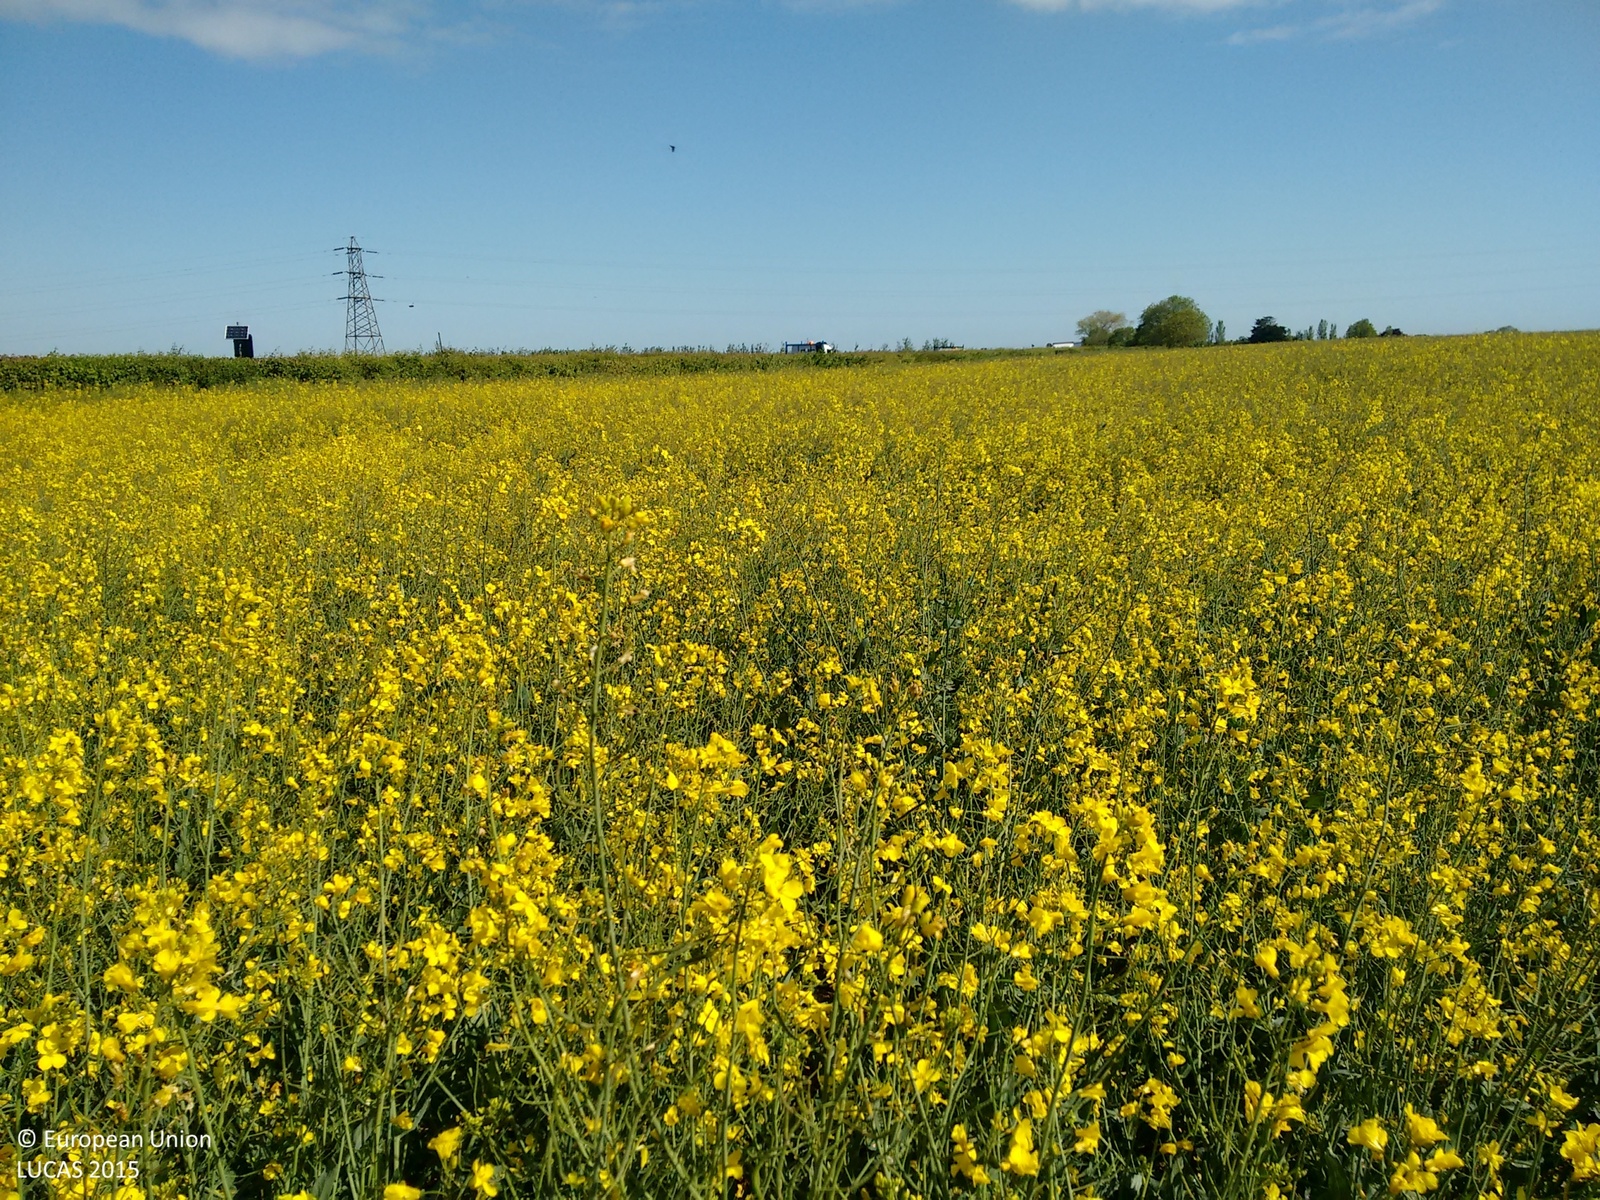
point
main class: Cropland
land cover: Rape and turnip rape
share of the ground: > 75 %
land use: Agriculture (excluding fallow land and kitchen gardens)
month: May
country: GB
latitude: 51.2453
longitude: 1.0811
